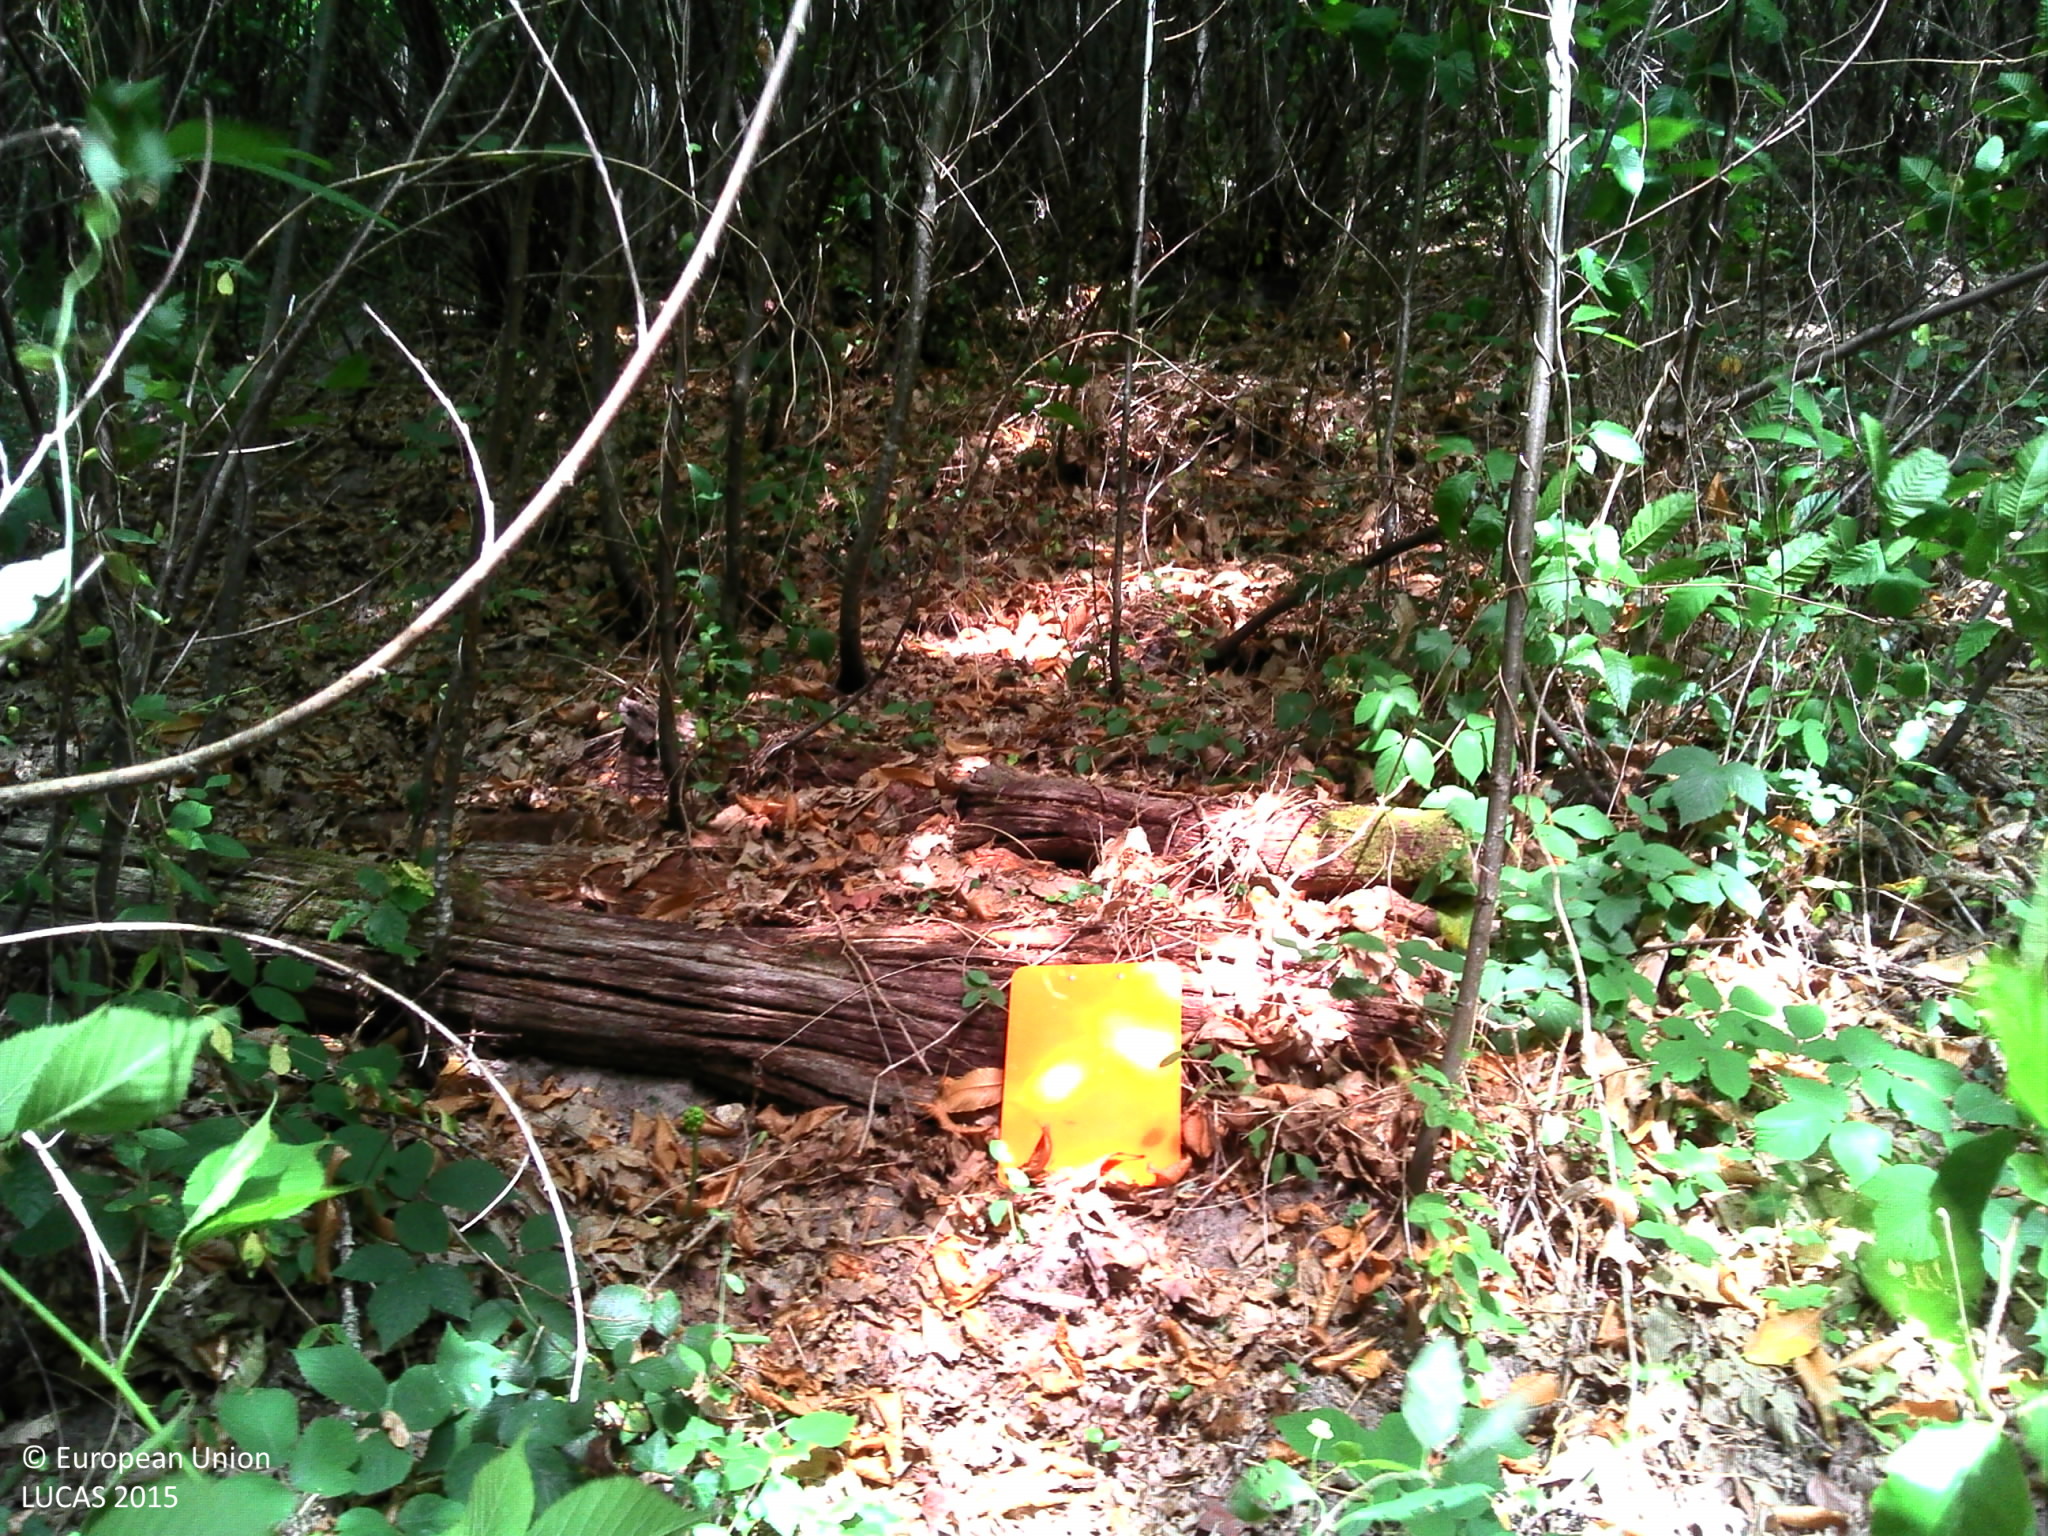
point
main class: Woodland
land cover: Broadleaved woodland
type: mesophytic deciduous forest
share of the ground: > 75 %
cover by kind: broadleaved forest trees 100 %
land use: Forestry
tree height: > 5 m
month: July
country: FR
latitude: 45.5348
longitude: 0.3689
